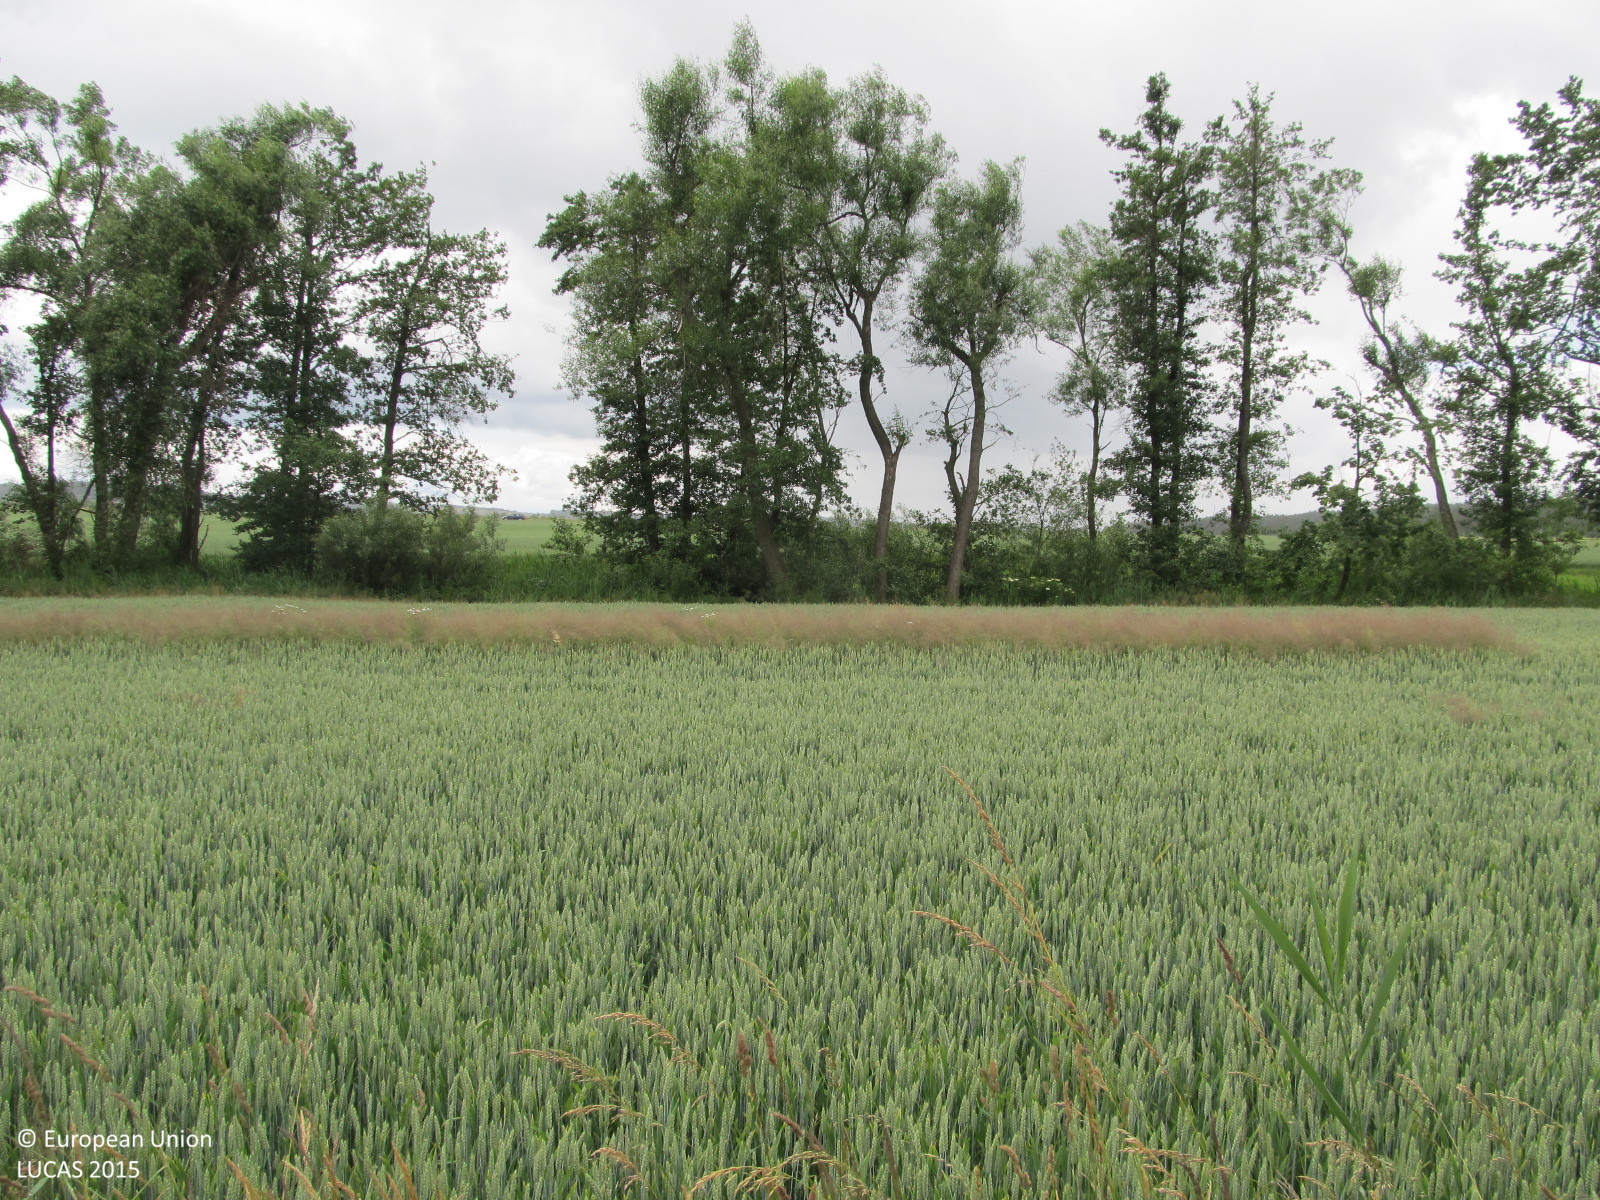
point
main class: Woodland
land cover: Broadleaved woodland
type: floodplain forest
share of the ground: > 75 %
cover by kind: broadleaved forest trees 80 %, shrubs 10 %, herbaceous plants 10 %
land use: Semi-natural and natural areas not in use
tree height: > 5 m
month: June
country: AT
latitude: 48.6480
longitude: 15.4457
